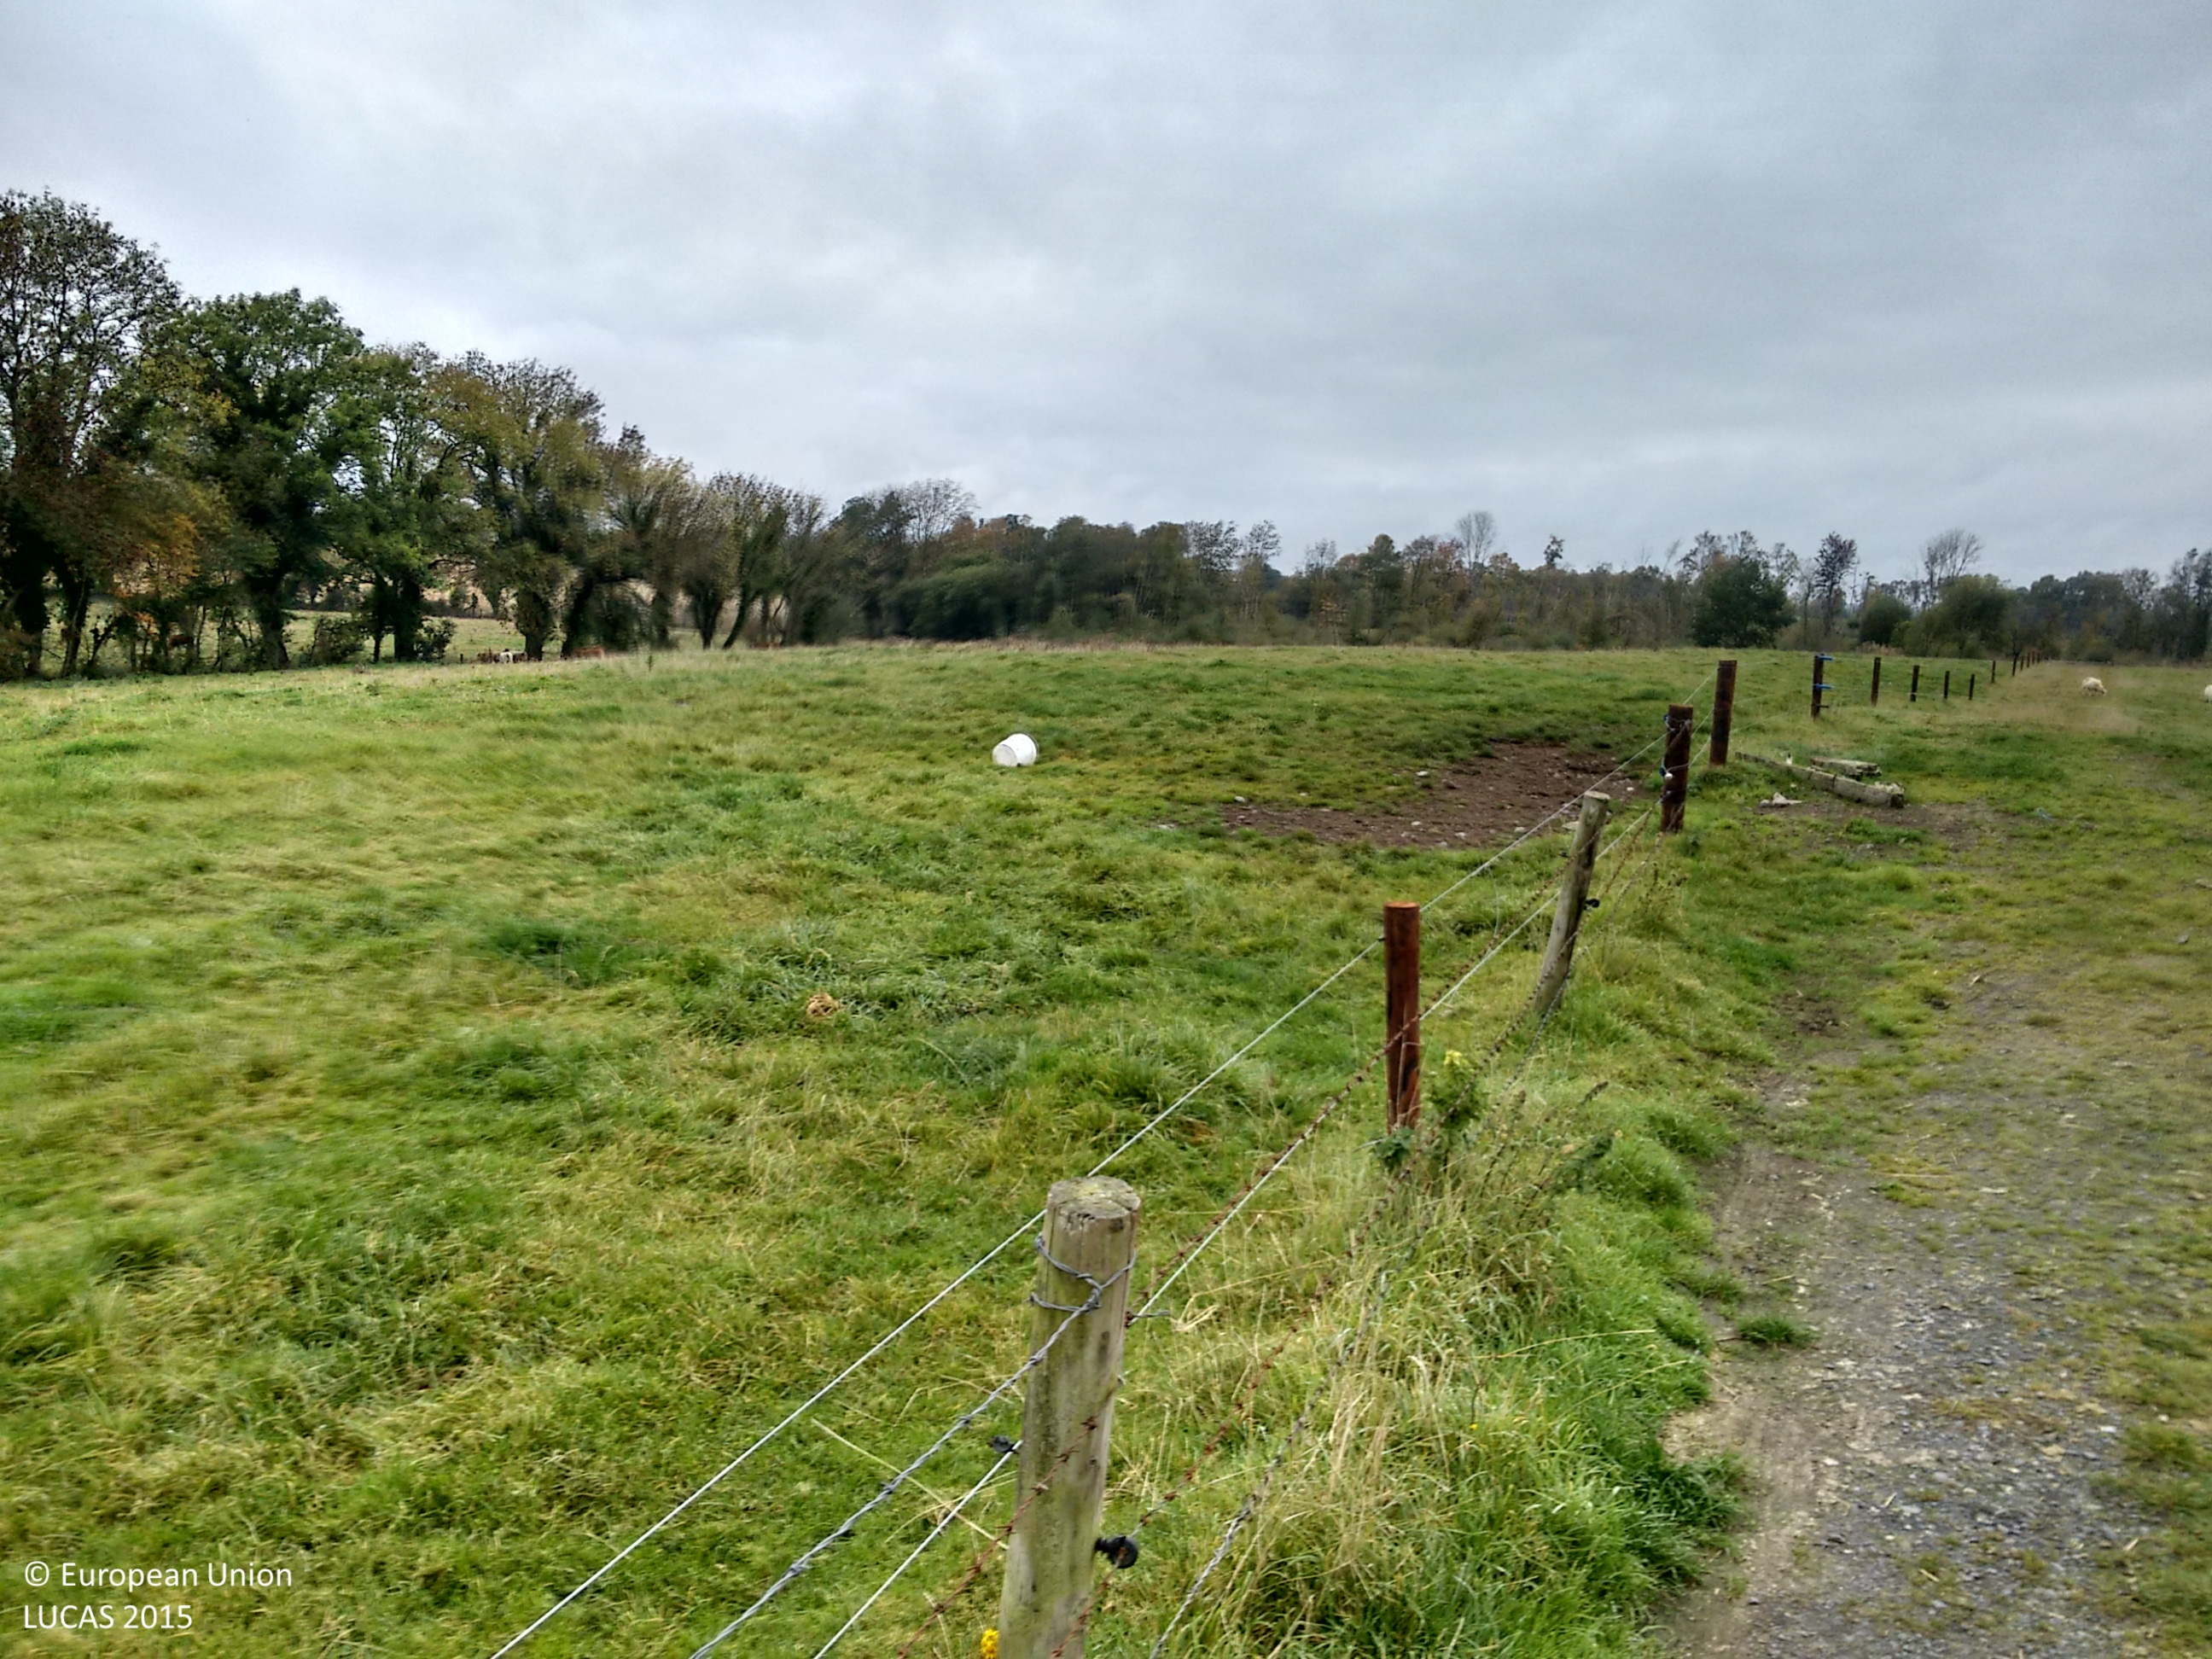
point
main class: Grassland
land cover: Grassland without tree/shrub cover
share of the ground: > 75 %
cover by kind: herbaceous plants 100 %
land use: Agriculture (excluding fallow land and kitchen gardens)
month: October
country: IE
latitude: 52.9946
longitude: -7.8863
